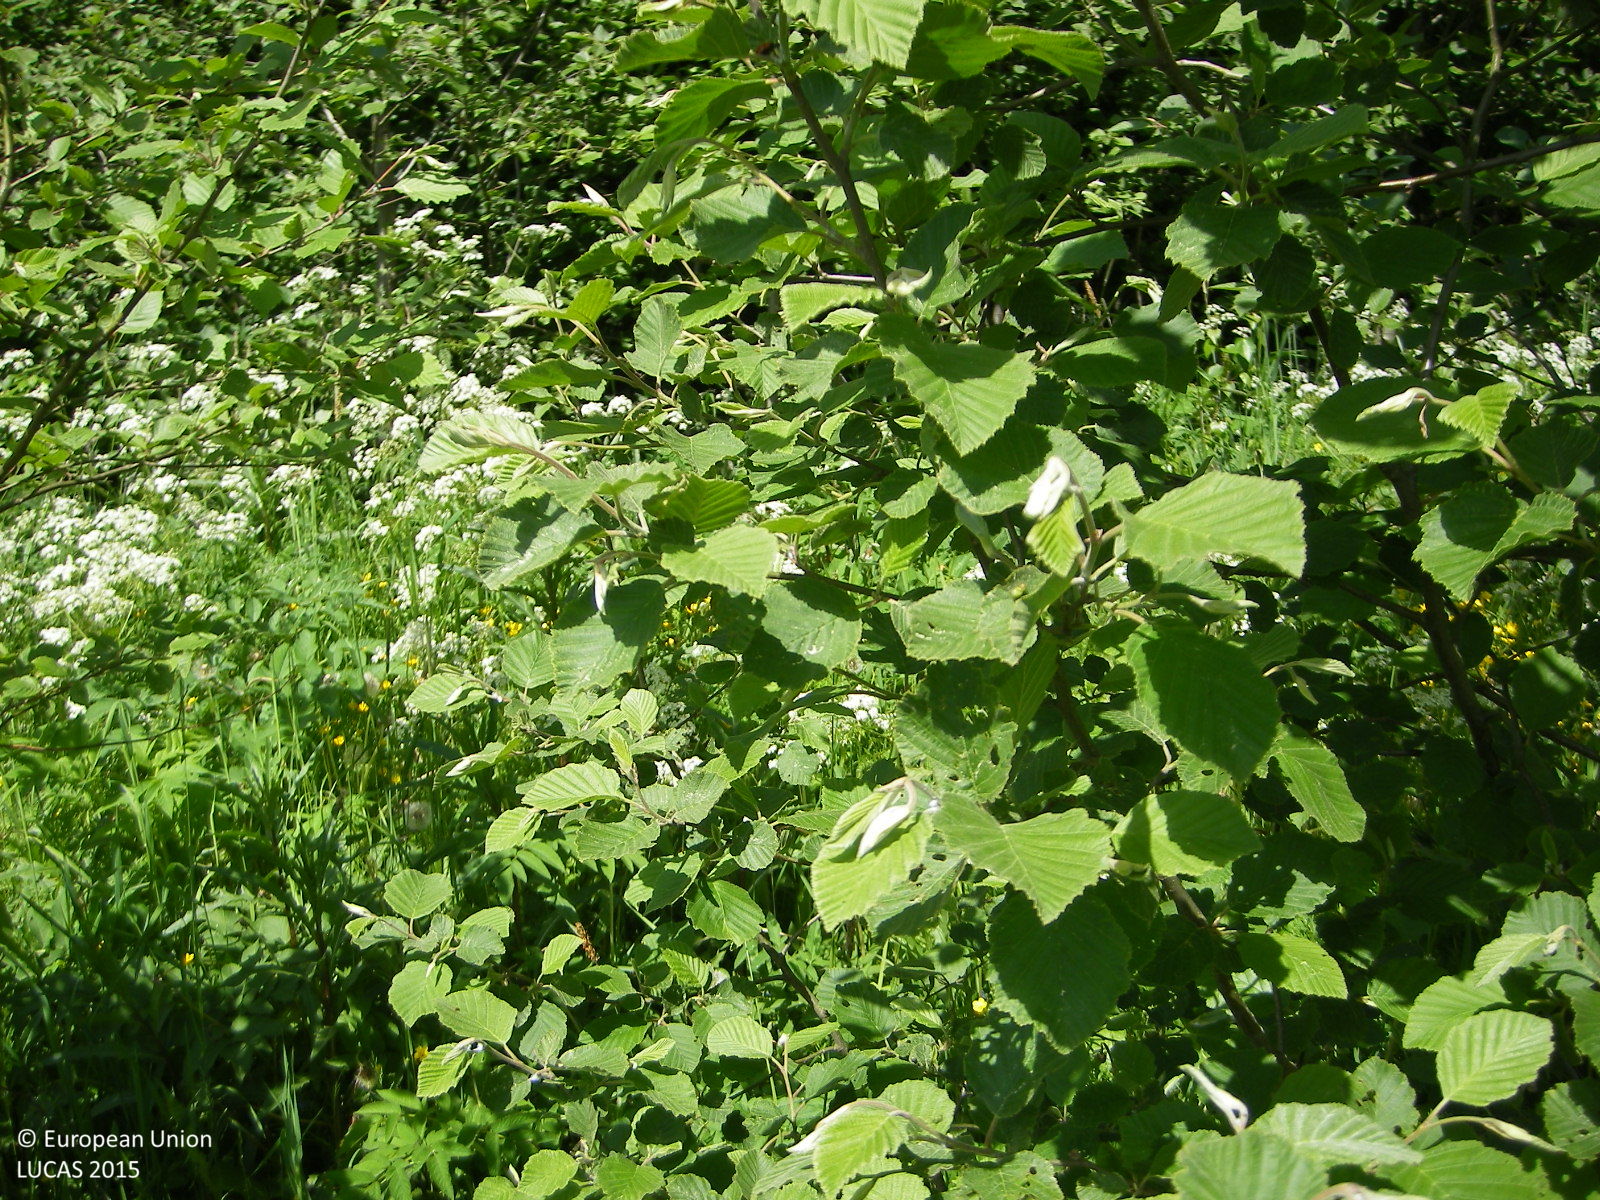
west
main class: Cropland
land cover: Other leguminous and mixtures for fodder
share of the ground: > 75 %
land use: Agriculture (excluding fallow land and kitchen gardens)
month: June
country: FI
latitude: 60.1427
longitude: 24.1292
